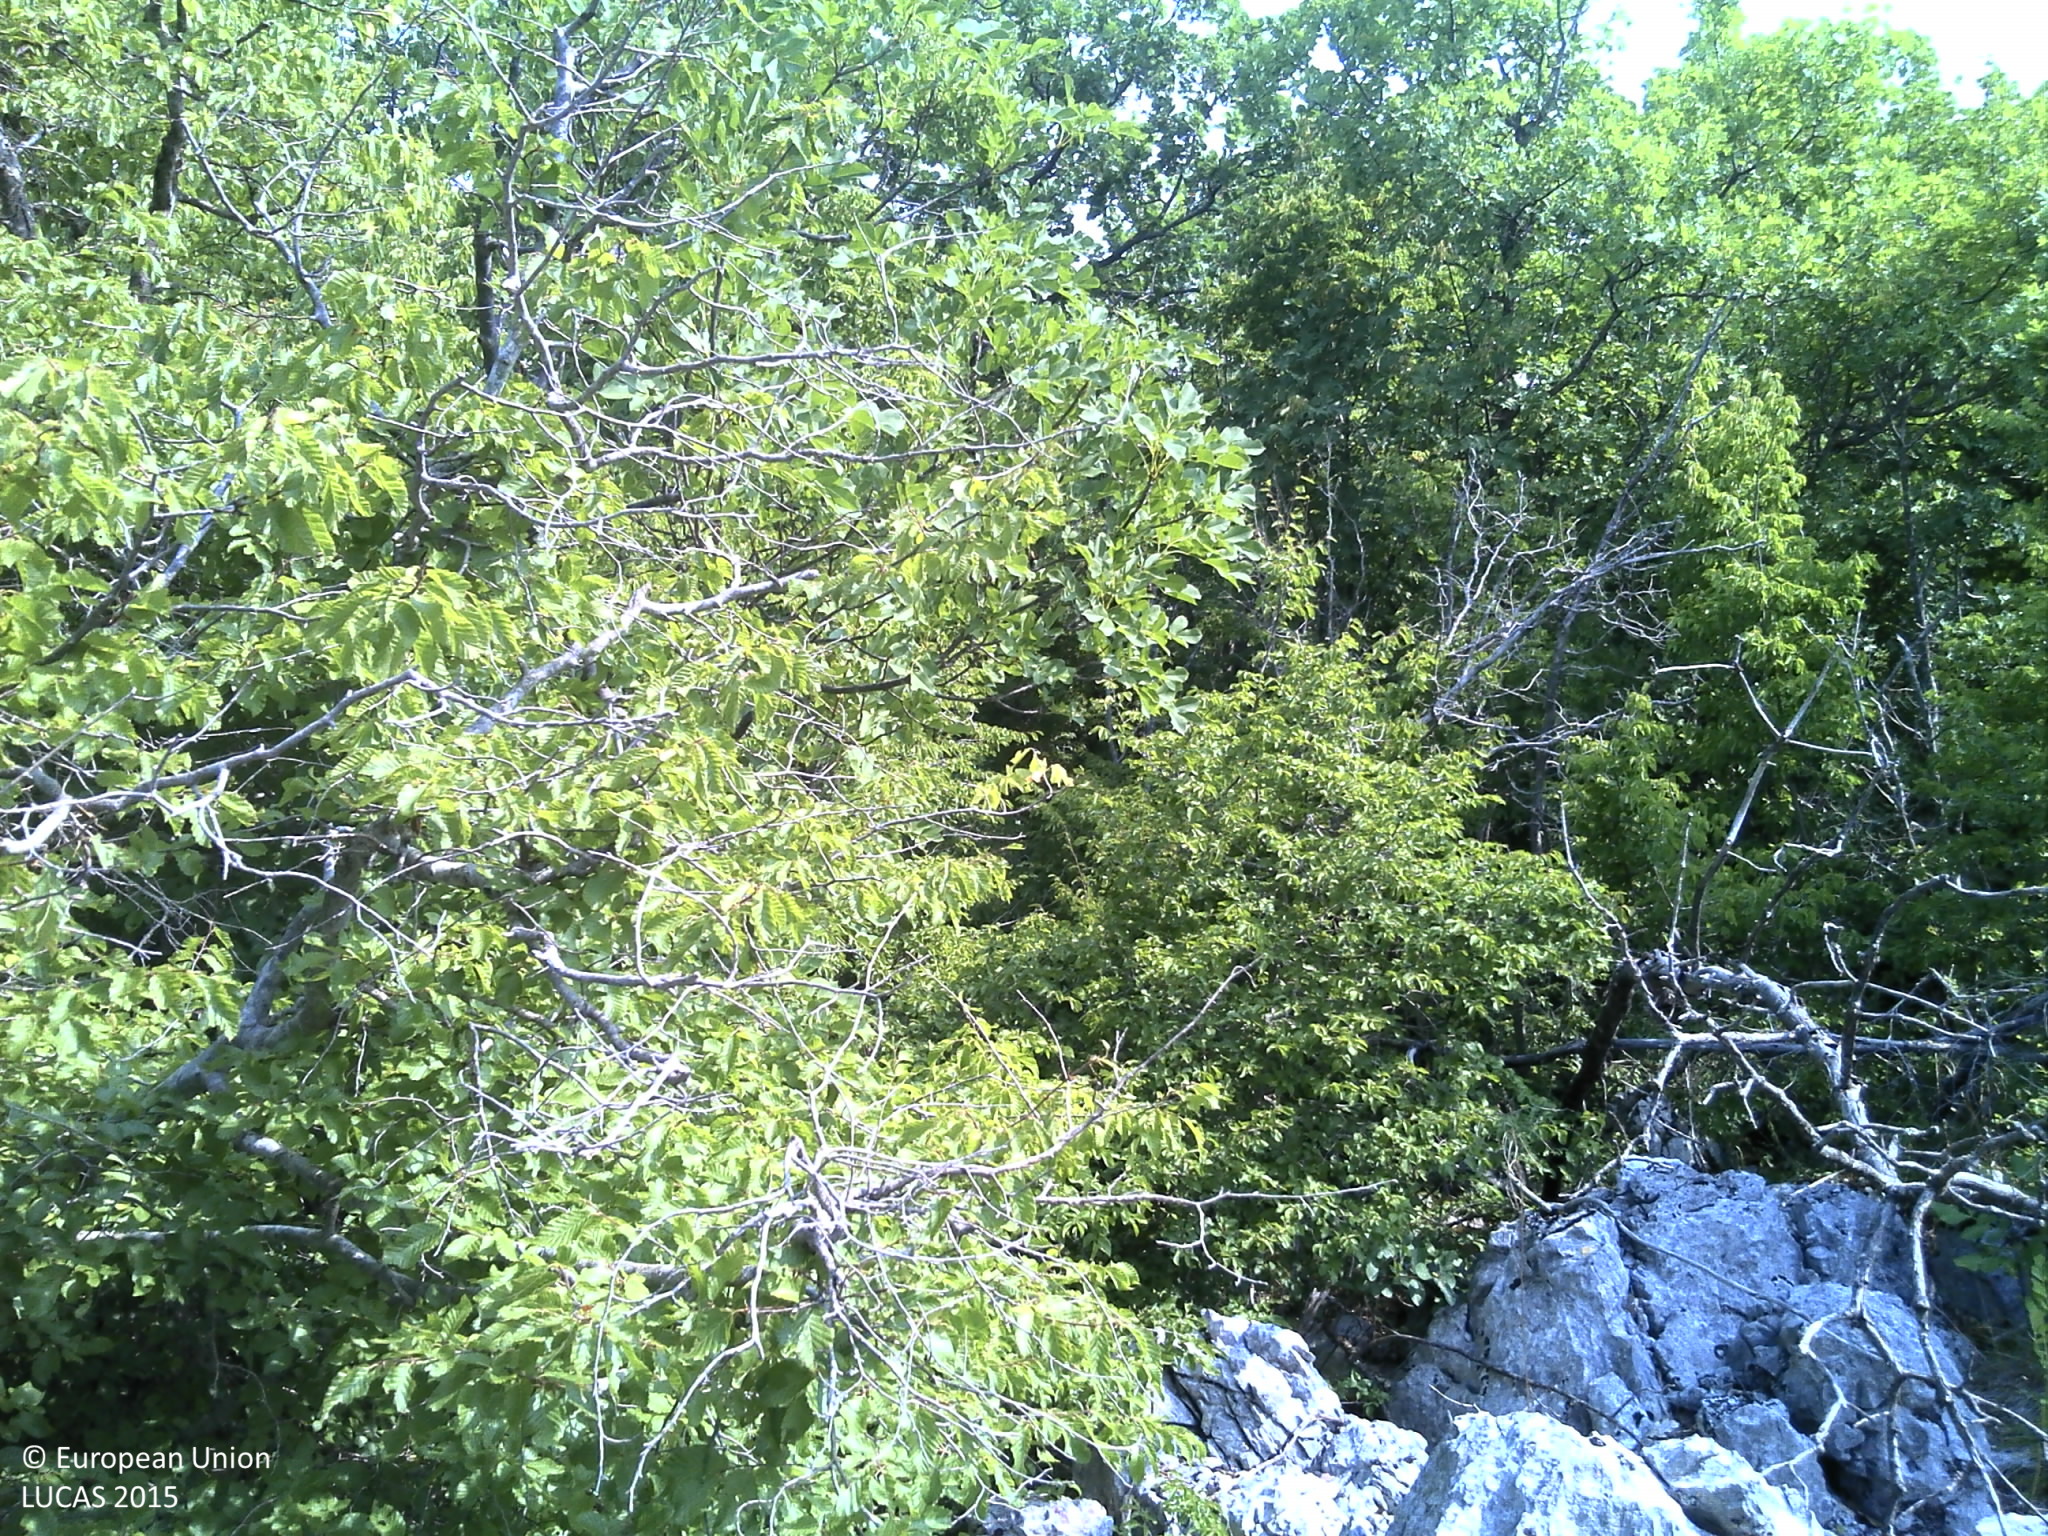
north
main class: Woodland
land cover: Other mixed woodland
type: thermophilous deciduous forest
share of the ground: > 75 %
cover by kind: broadleaved forest trees 45 %, coniferous forest trees 30 %, shrubs 10 %, consolidated bare surface 10 %, herbaceous plants 5 %
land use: Semi-natural and natural areas not in use
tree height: > 5 m
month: July
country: HR
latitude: 43.4853
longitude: 16.9280
